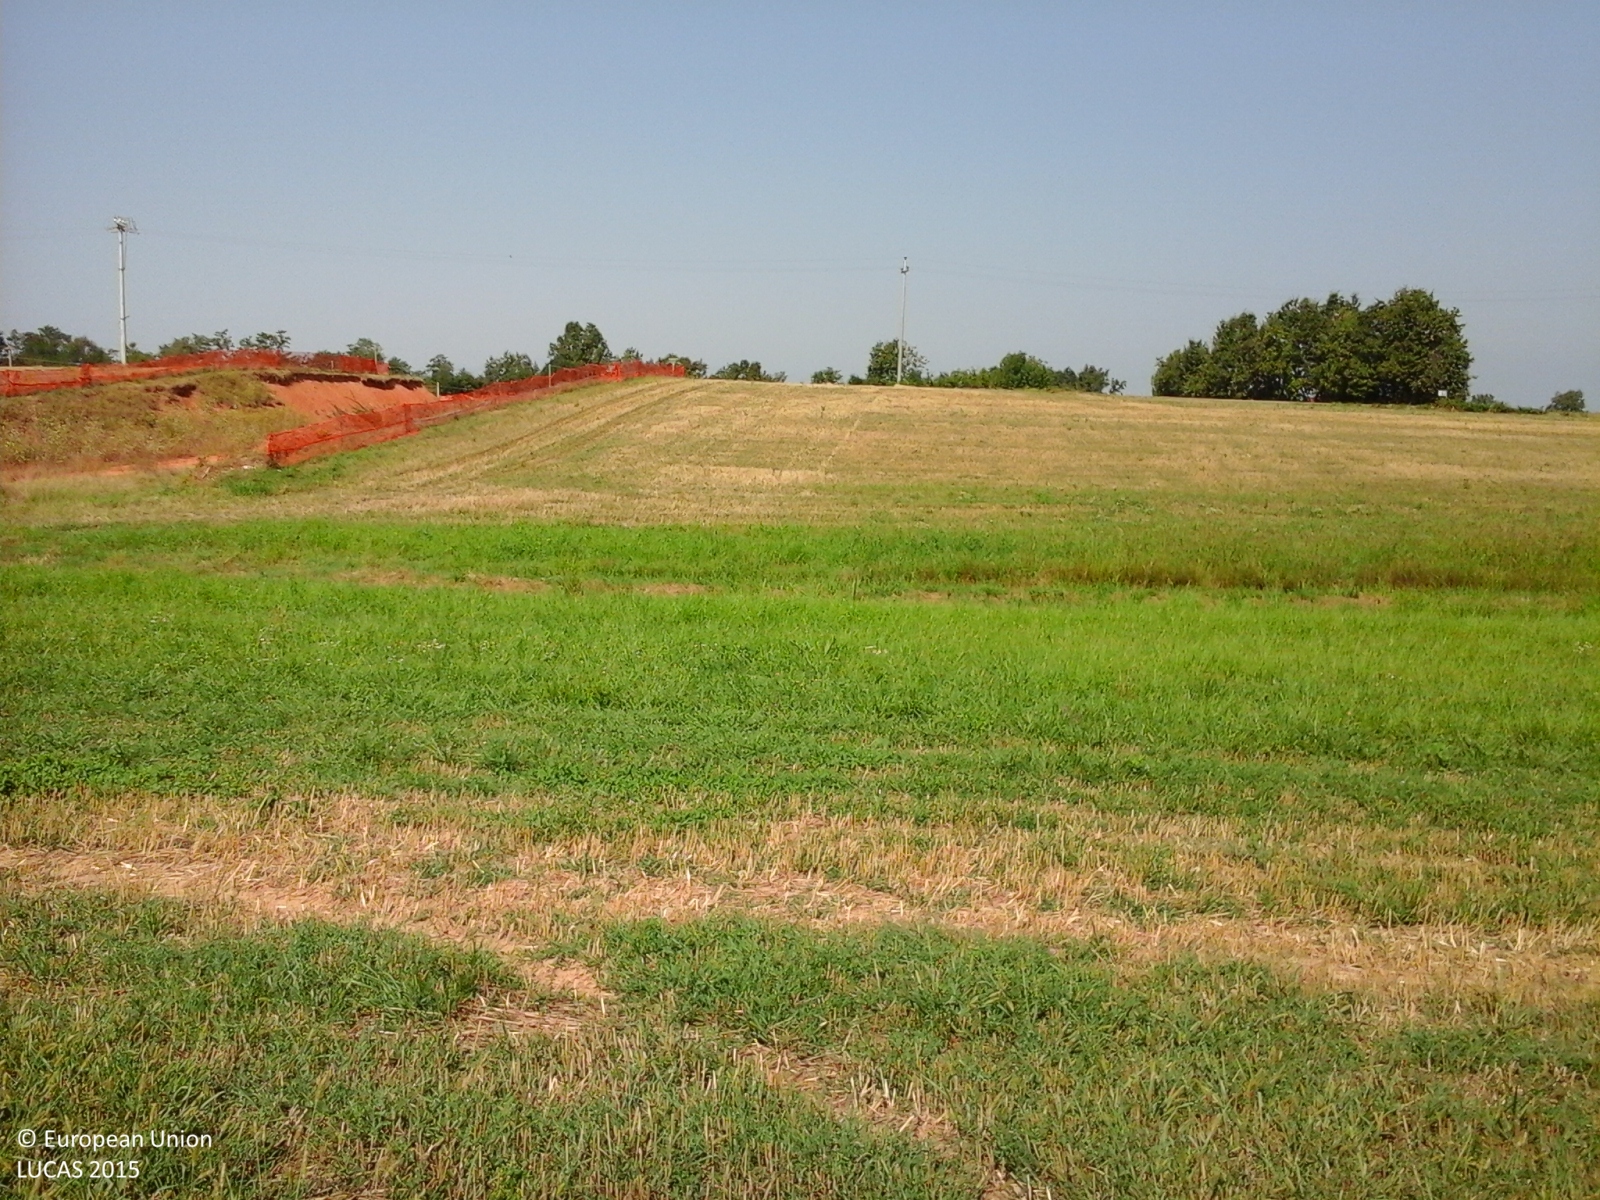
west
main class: Cropland
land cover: Common wheat
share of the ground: > 75 %
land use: Agriculture (excluding fallow land and kitchen gardens)
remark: Harvested field
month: August
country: IT
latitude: 44.3805
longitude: 7.7581
